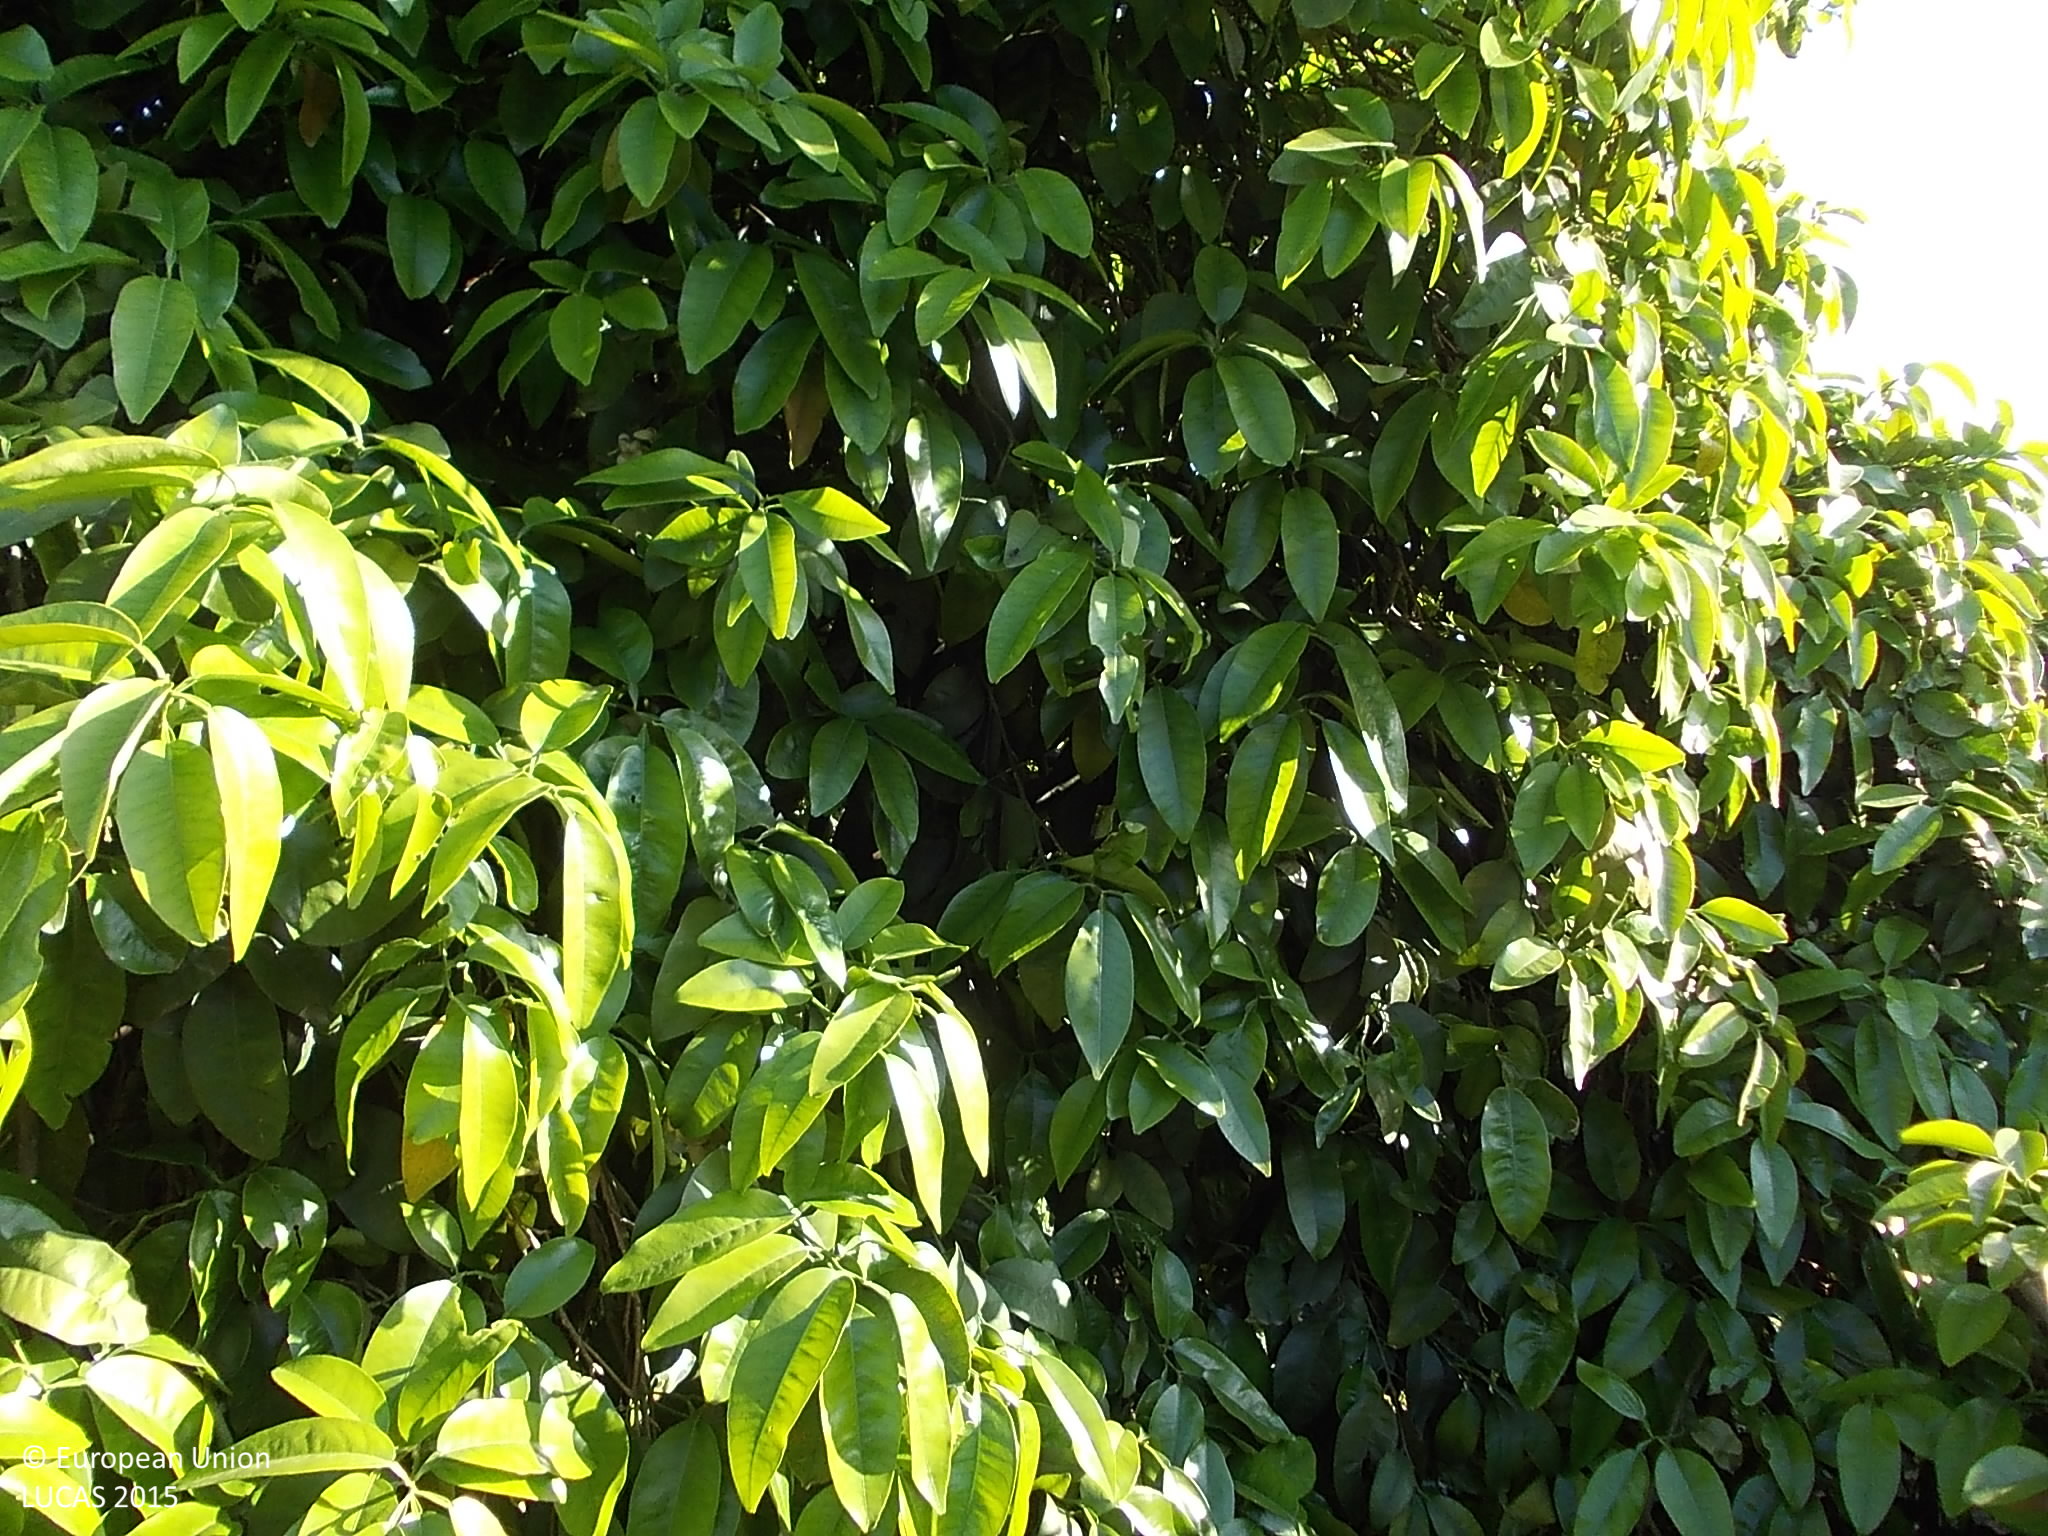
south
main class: Cropland
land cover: Oranges
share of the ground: > 75 %
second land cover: Spontaneously vegetated surfaces
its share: > 75 %
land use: Agriculture (excluding fallow land and kitchen gardens)
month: April
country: CY
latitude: 34.6850
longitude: 32.9862
